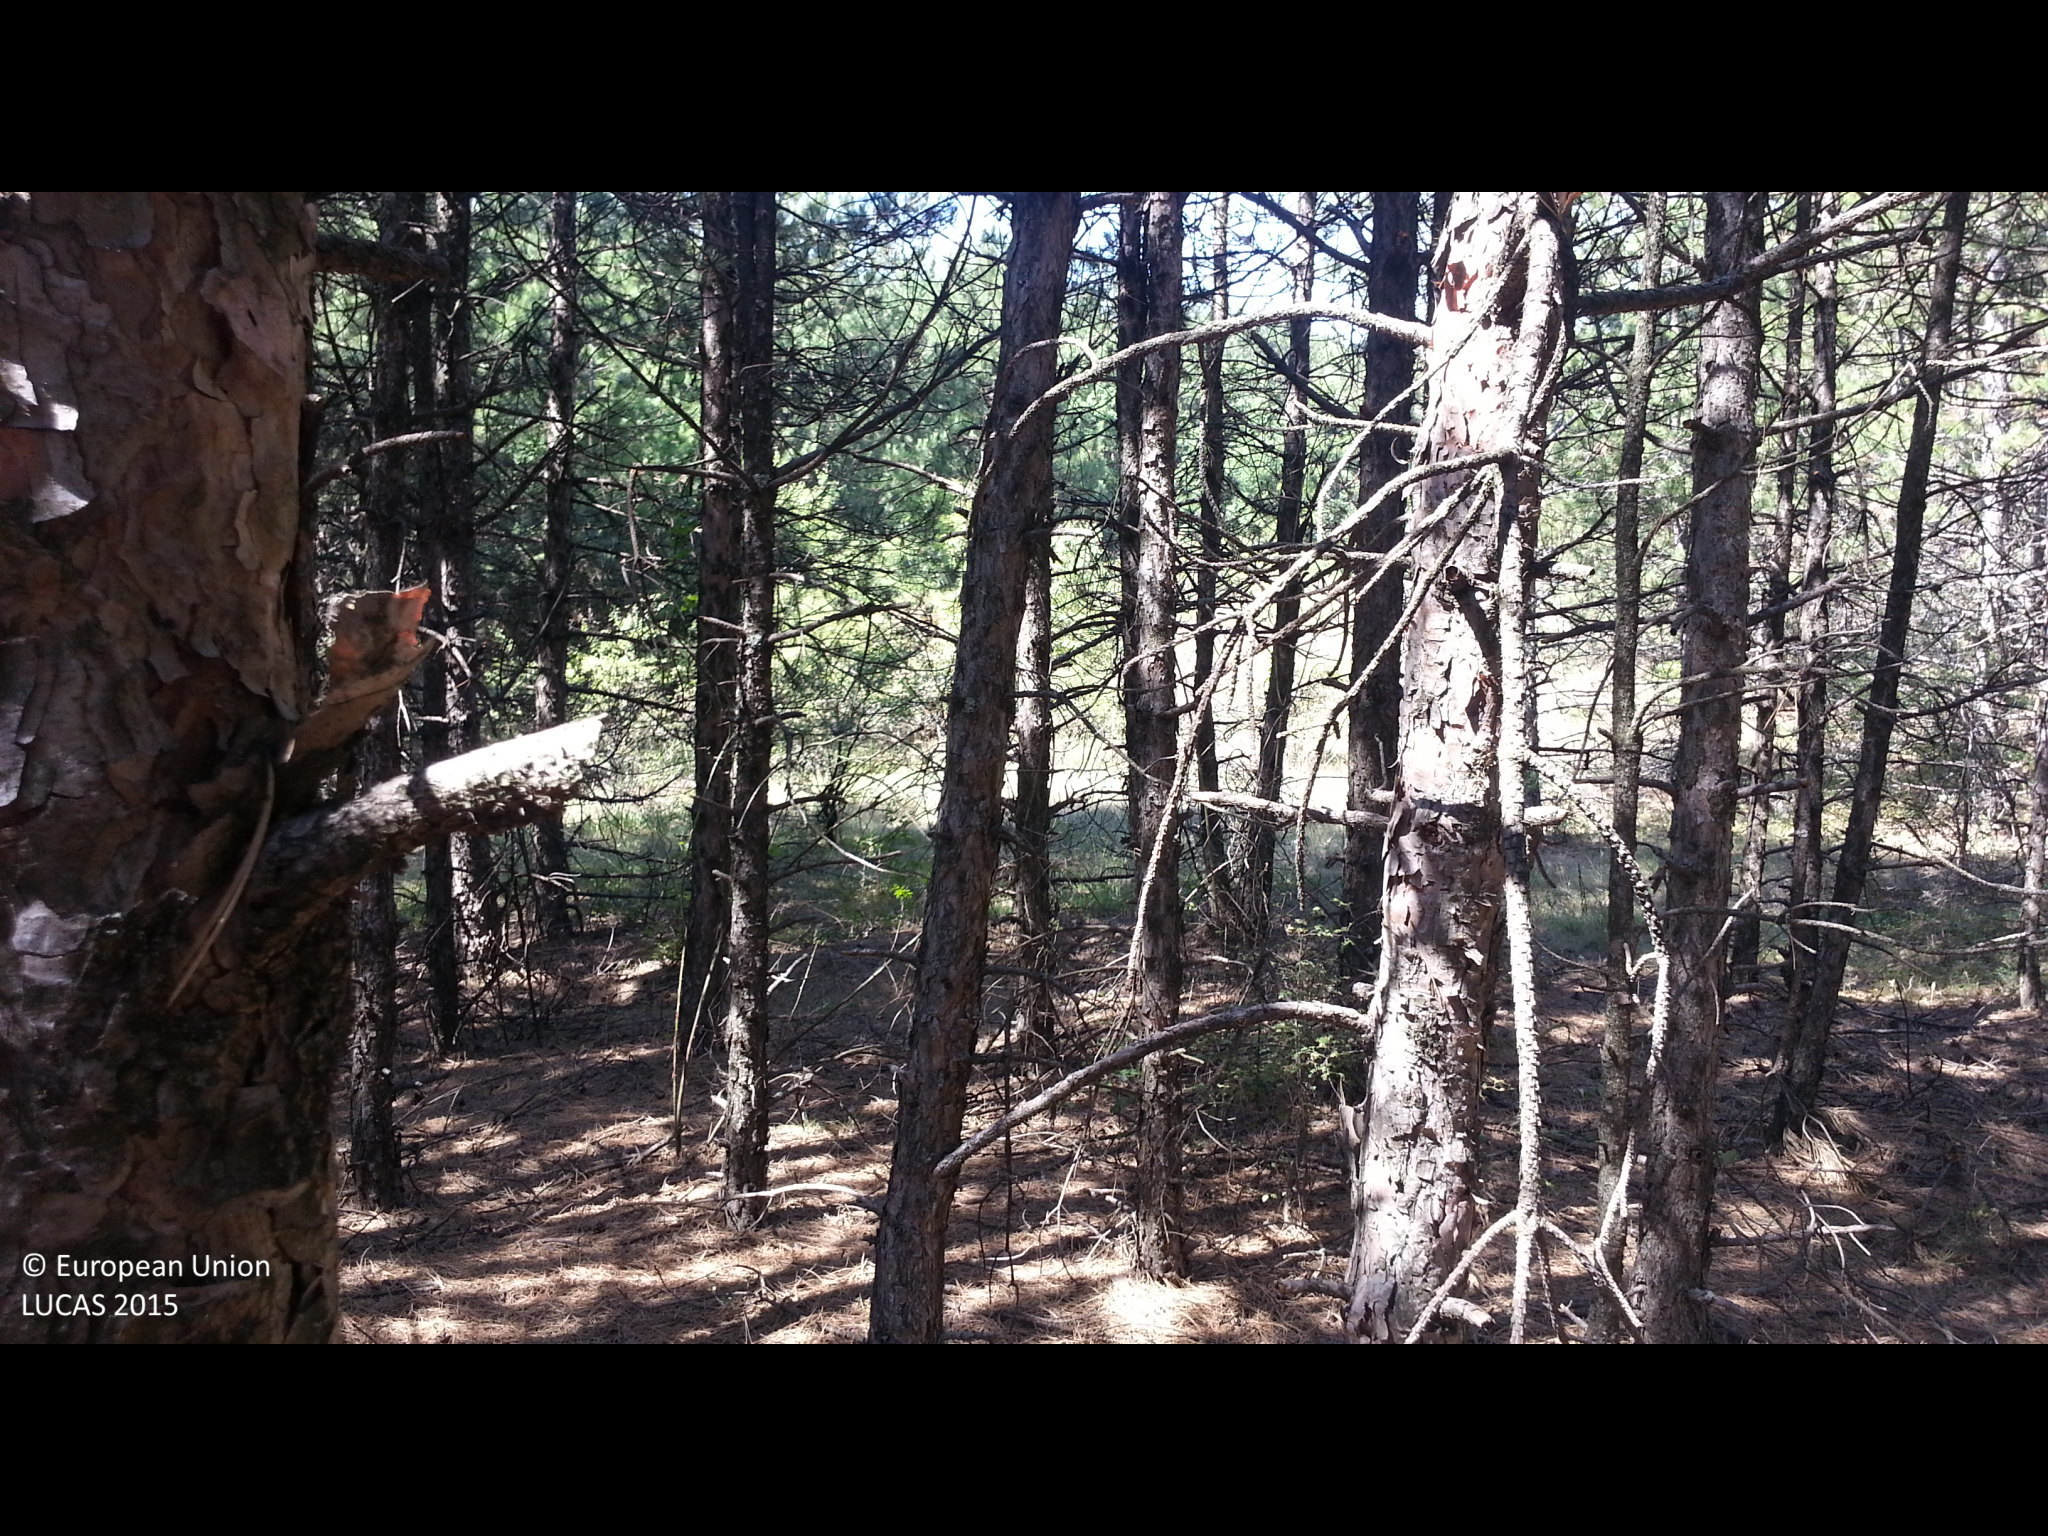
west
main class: Woodland
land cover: Pine dominated coniferous woodland
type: hemiboreal forest and nemoral coniferous forest and mixed broadleaved-coniferous forest
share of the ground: > 75 %
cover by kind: coniferous forest trees 100 %
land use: Forestry
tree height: > 5 m
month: August
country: BG
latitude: 42.5069
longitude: 23.1367
